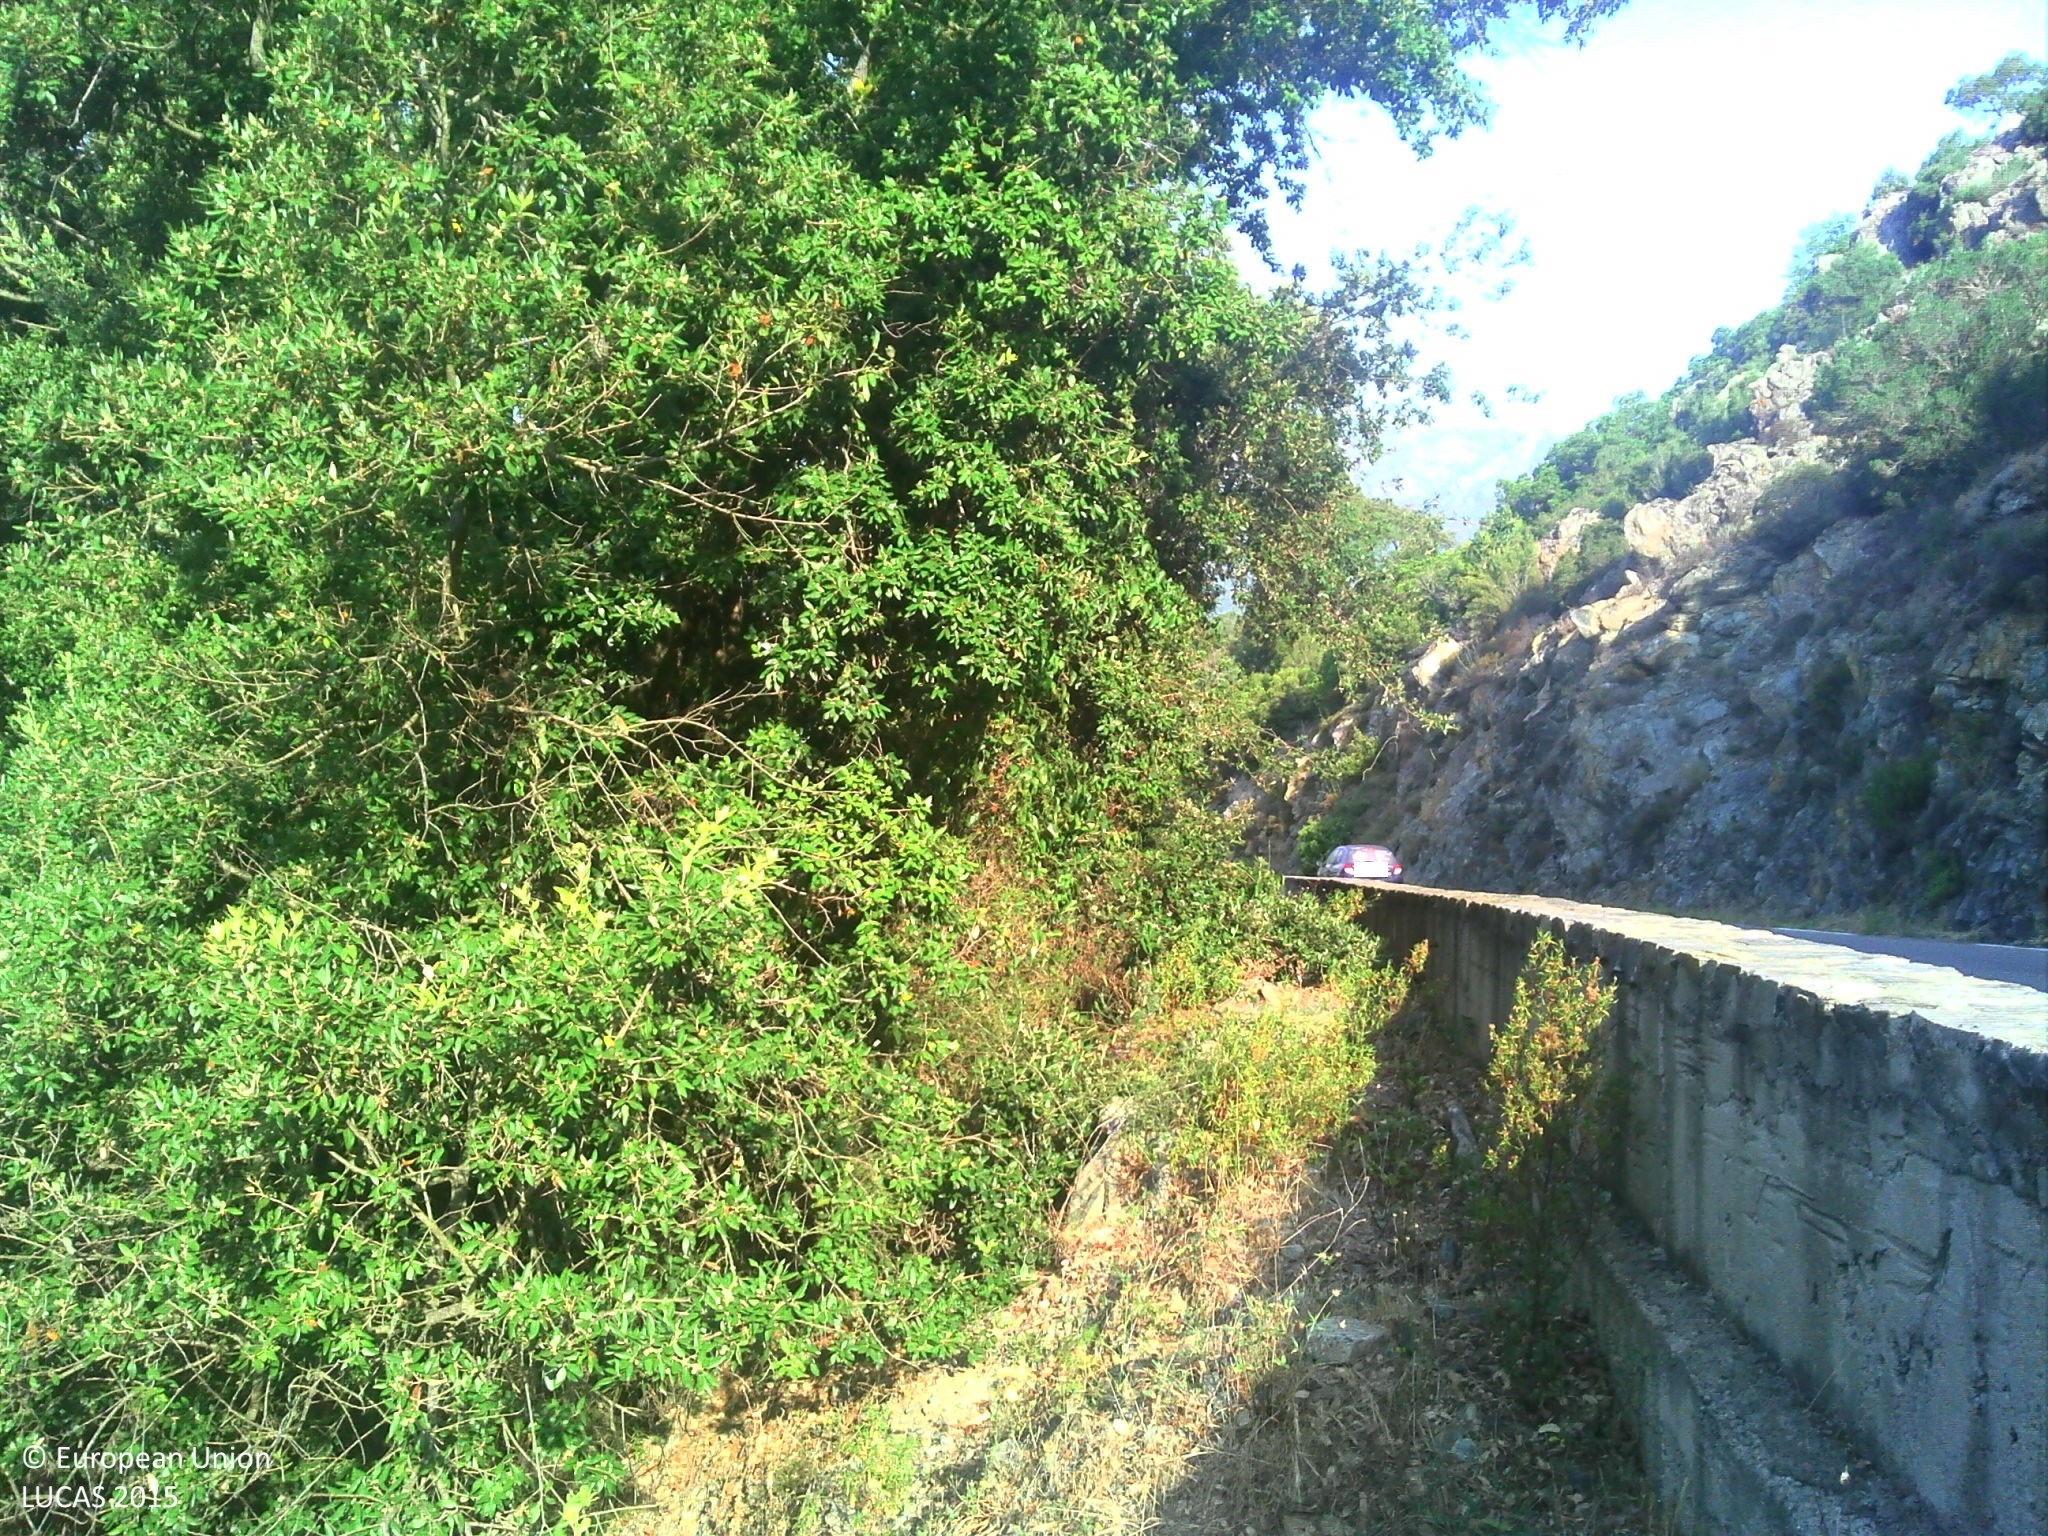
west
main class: Shrubland
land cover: Shrubland without tree cover
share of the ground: > 75 %
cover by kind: shrubs 80 %, consolidated bare surface 20 %
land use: Semi-natural and natural areas not in use
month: July
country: FR
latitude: 42.5073
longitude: 9.3330
